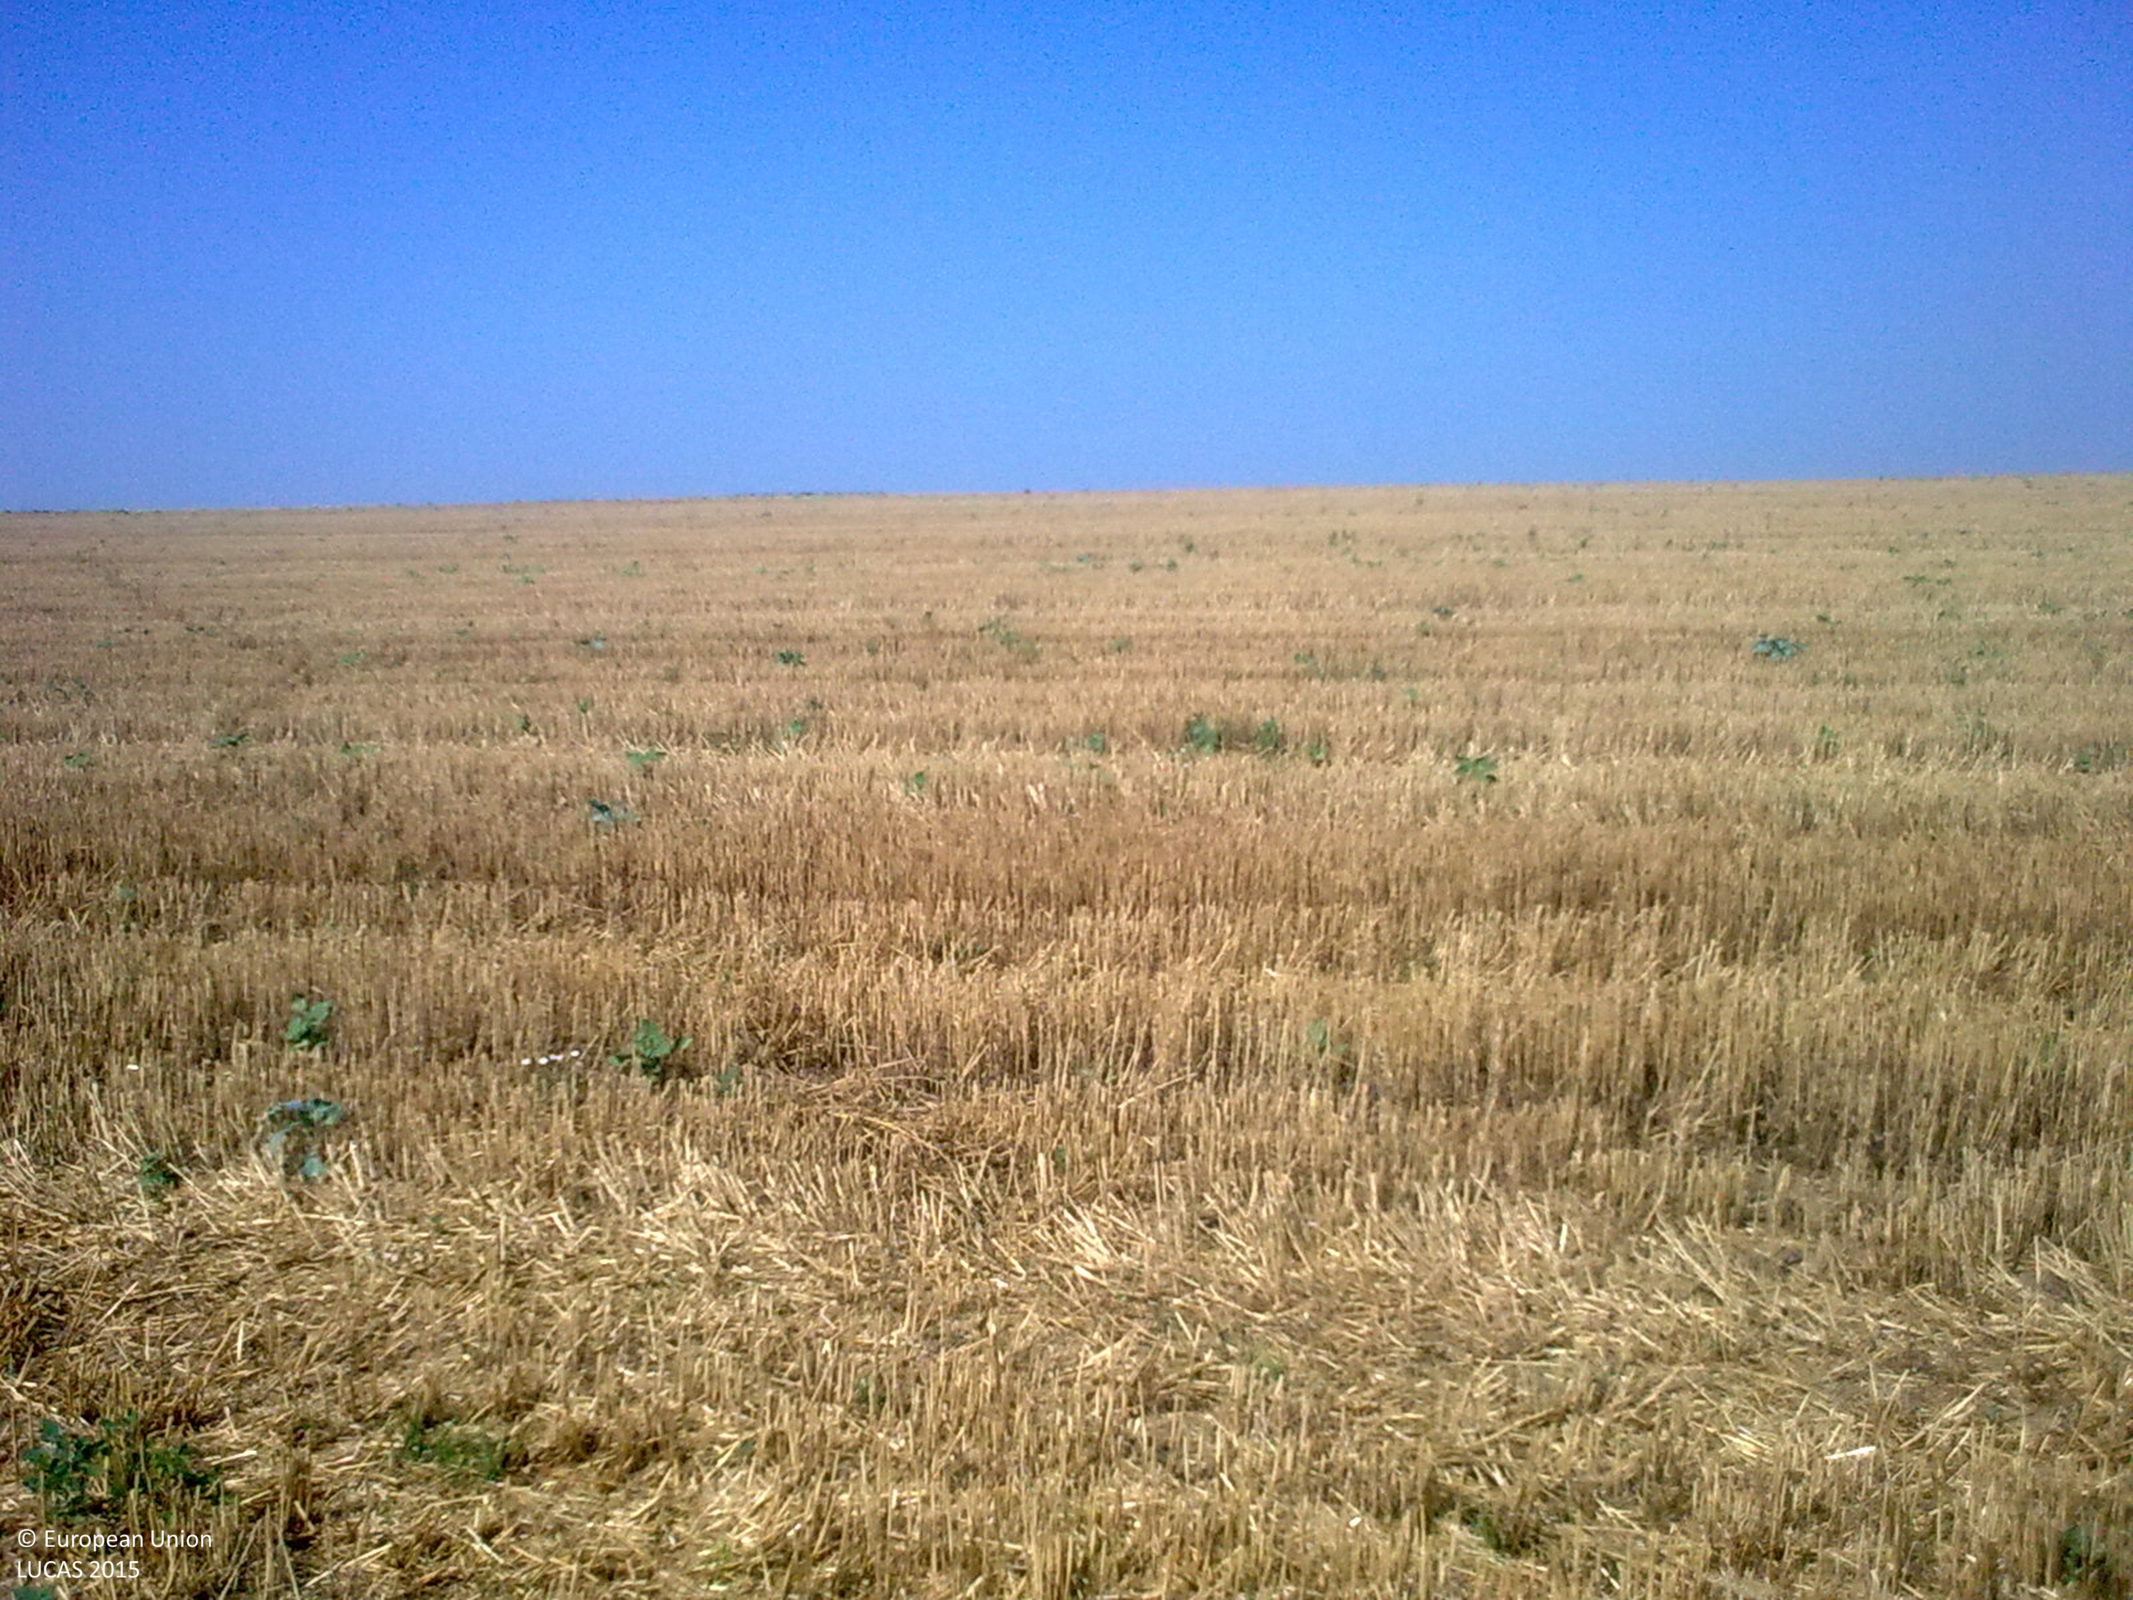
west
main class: Cropland
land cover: Common wheat
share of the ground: 50 - 75 %
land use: Agriculture (excluding fallow land and kitchen gardens)
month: July
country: BG
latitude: 43.7870
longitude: 26.2946
